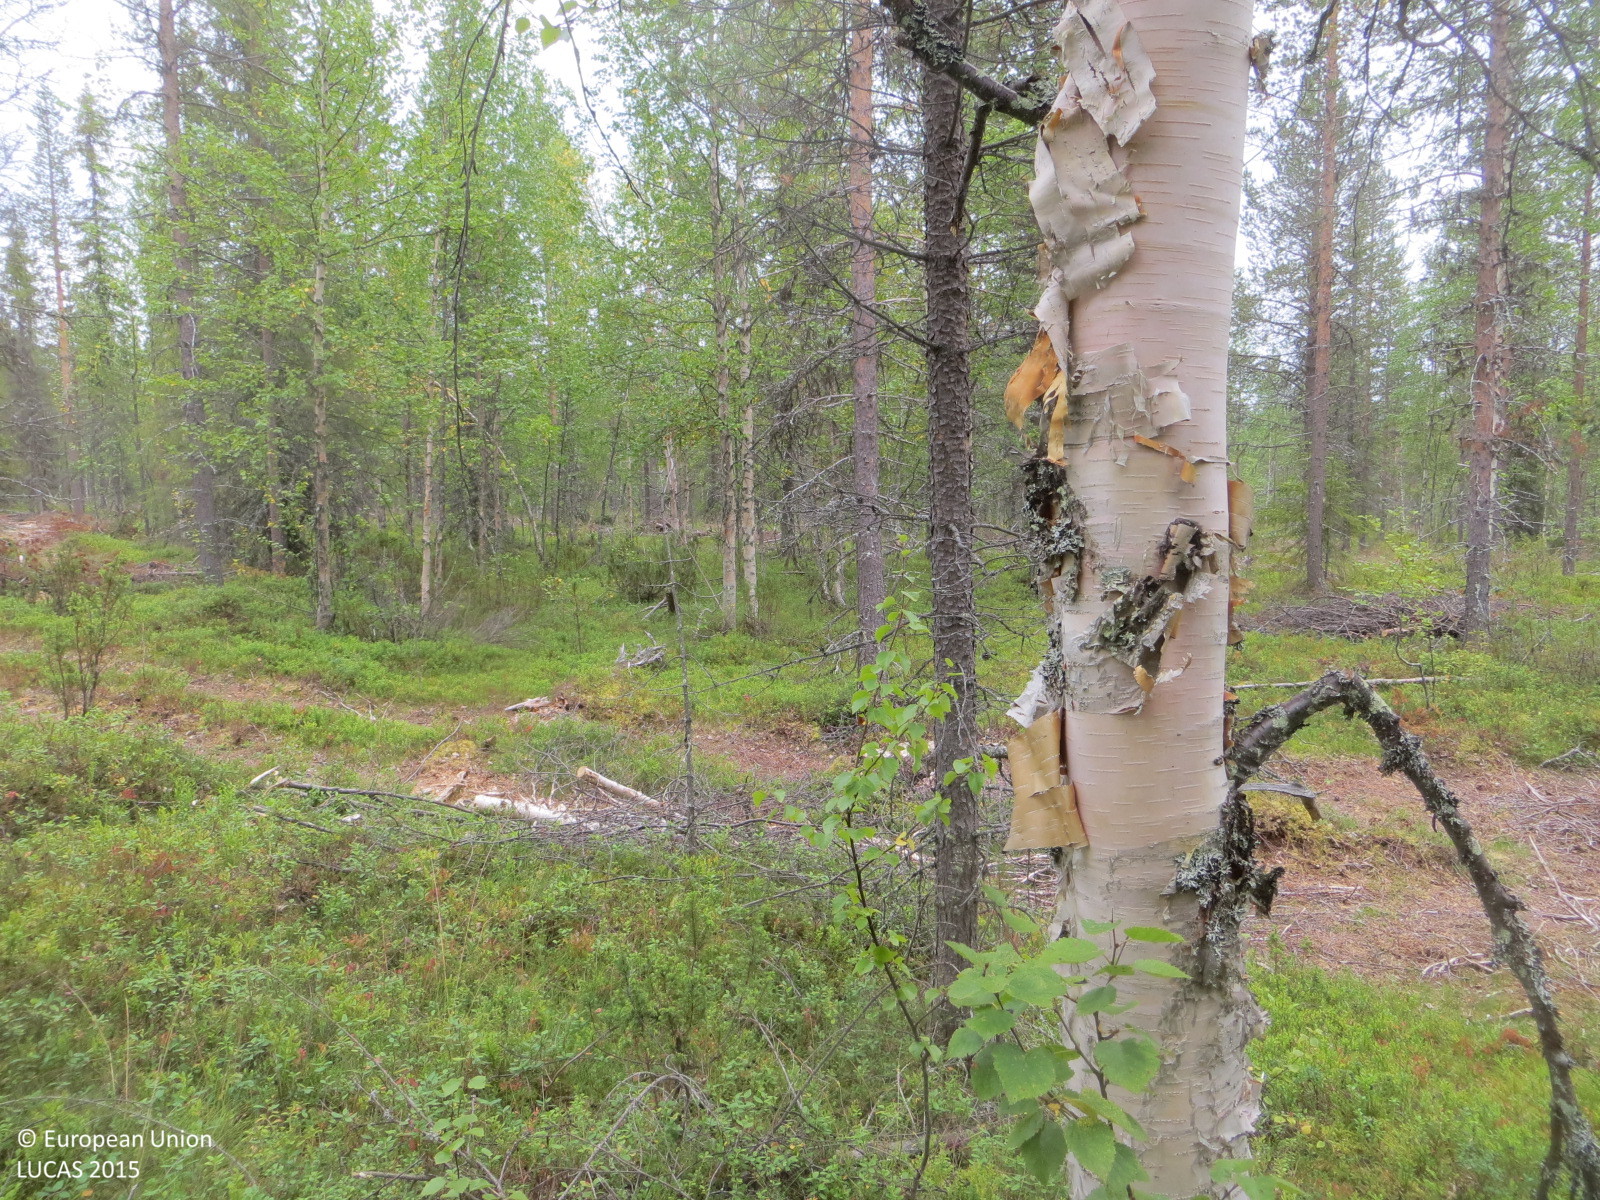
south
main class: Woodland
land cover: Pine dominated mixed woodland
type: boreal forest
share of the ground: 50 - 75 %
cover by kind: broadleaved forest trees 40 %, shrubs 40 %, coniferous forest trees 20 %
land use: Forestry
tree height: > 5 m
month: August
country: FI
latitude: 67.9943
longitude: 25.1732
